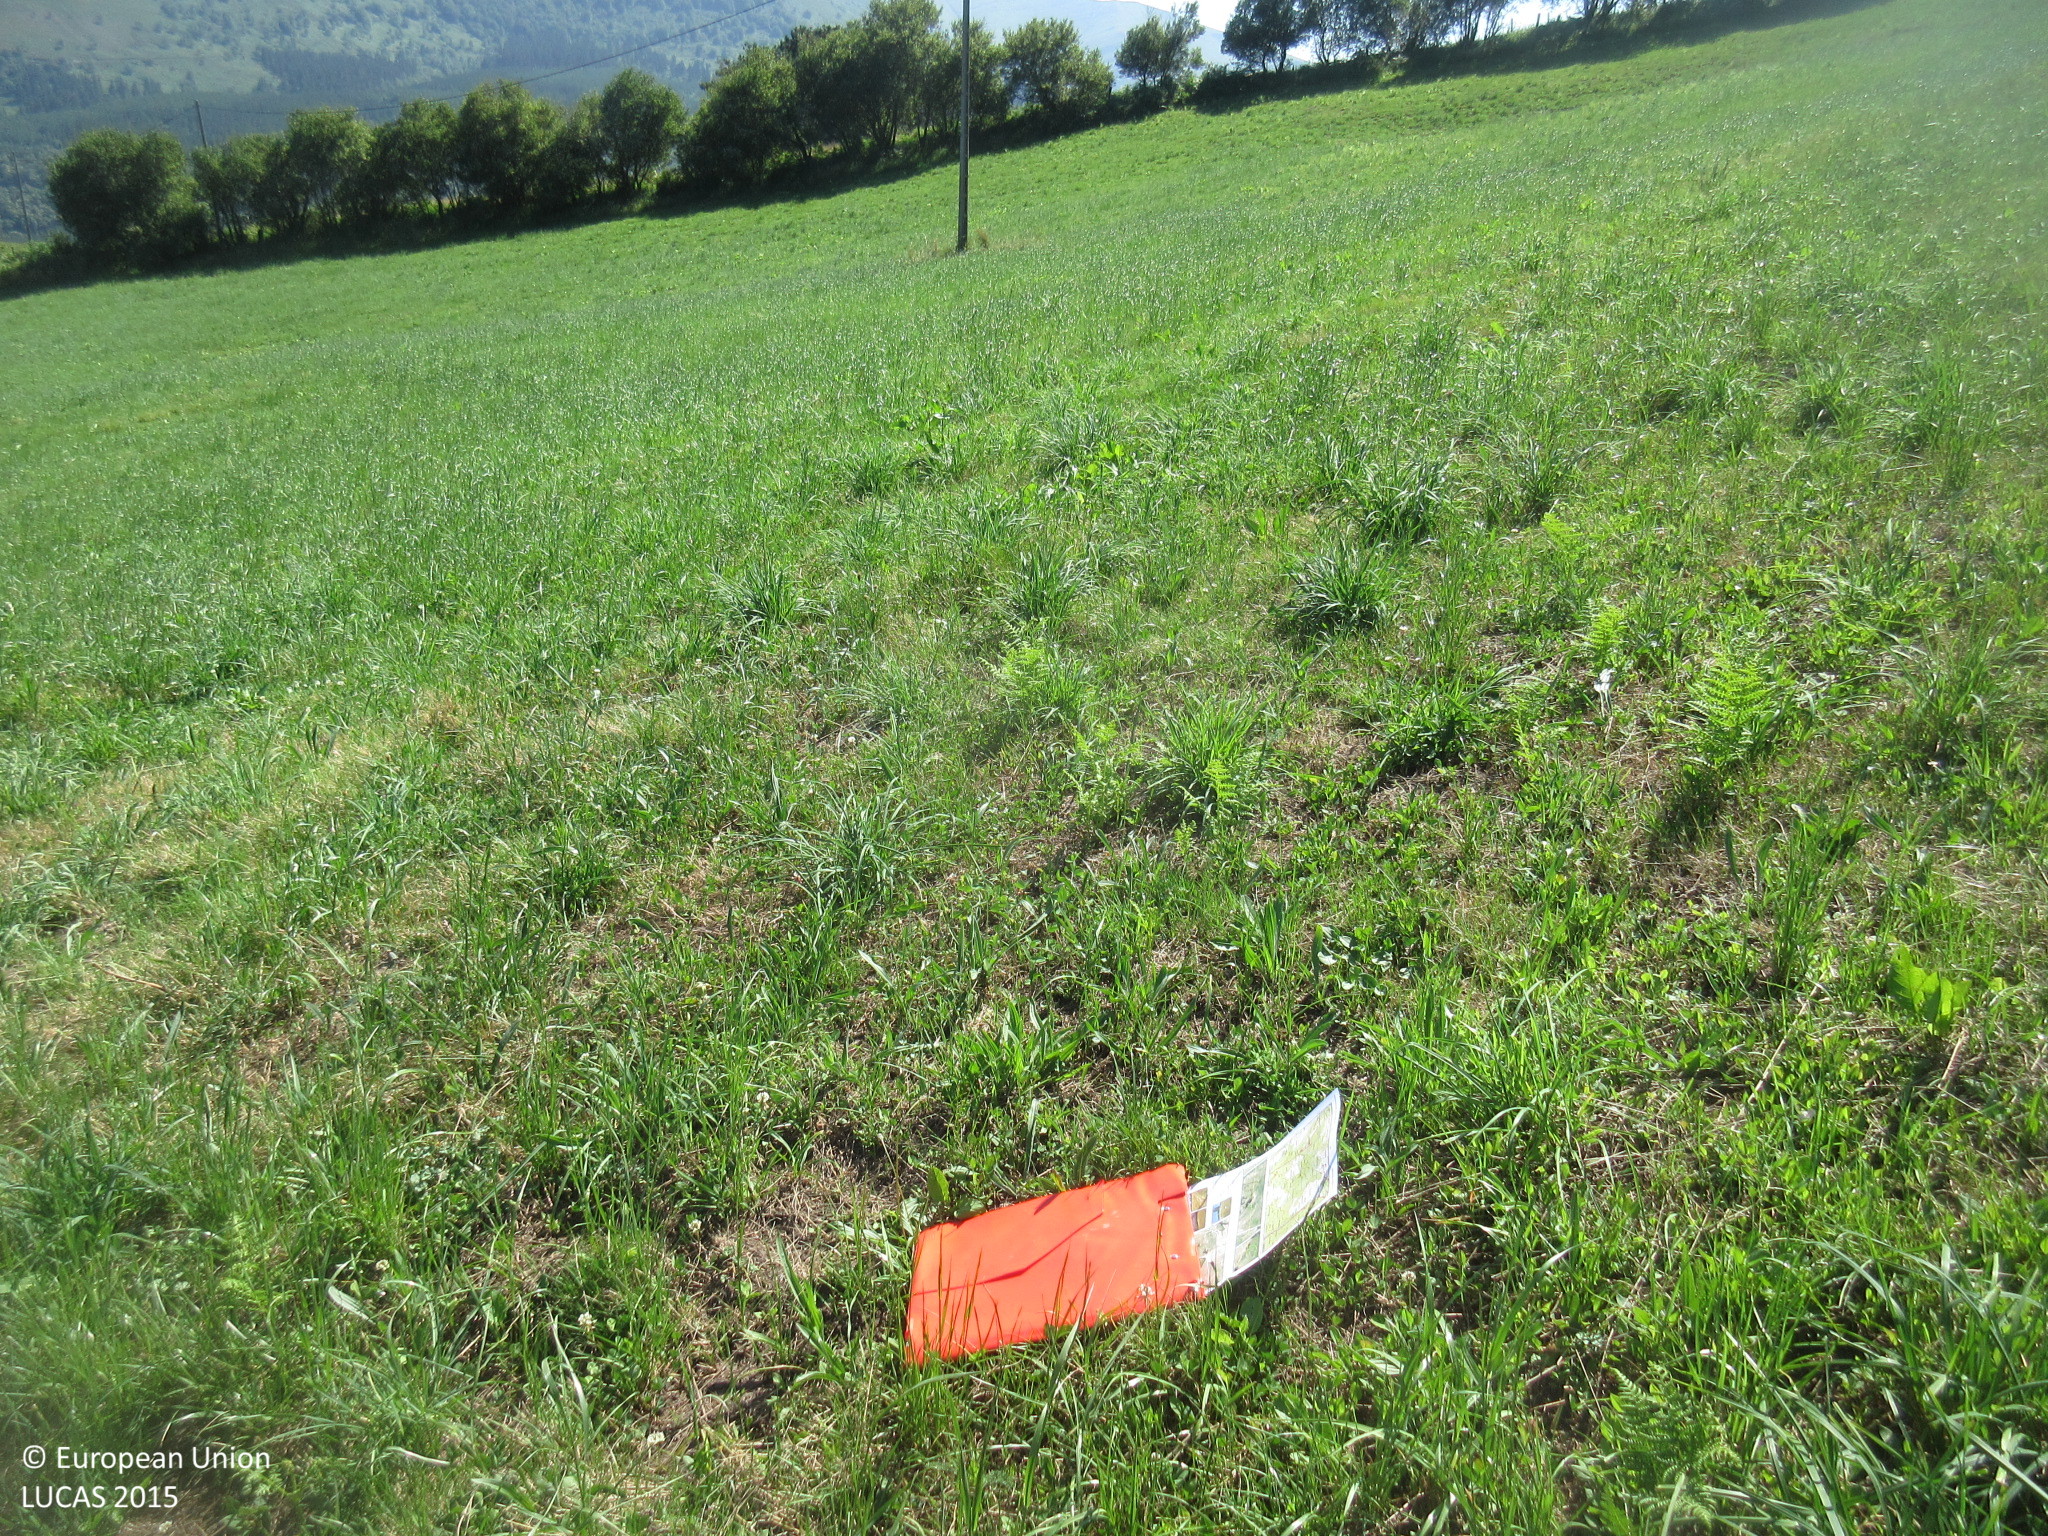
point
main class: Grassland
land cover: Grassland without tree/shrub cover
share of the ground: > 75 %
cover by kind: herbaceous plants 100 %
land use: Agriculture (excluding fallow land and kitchen gardens)
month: July
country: ES
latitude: 43.1860
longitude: -3.3898
